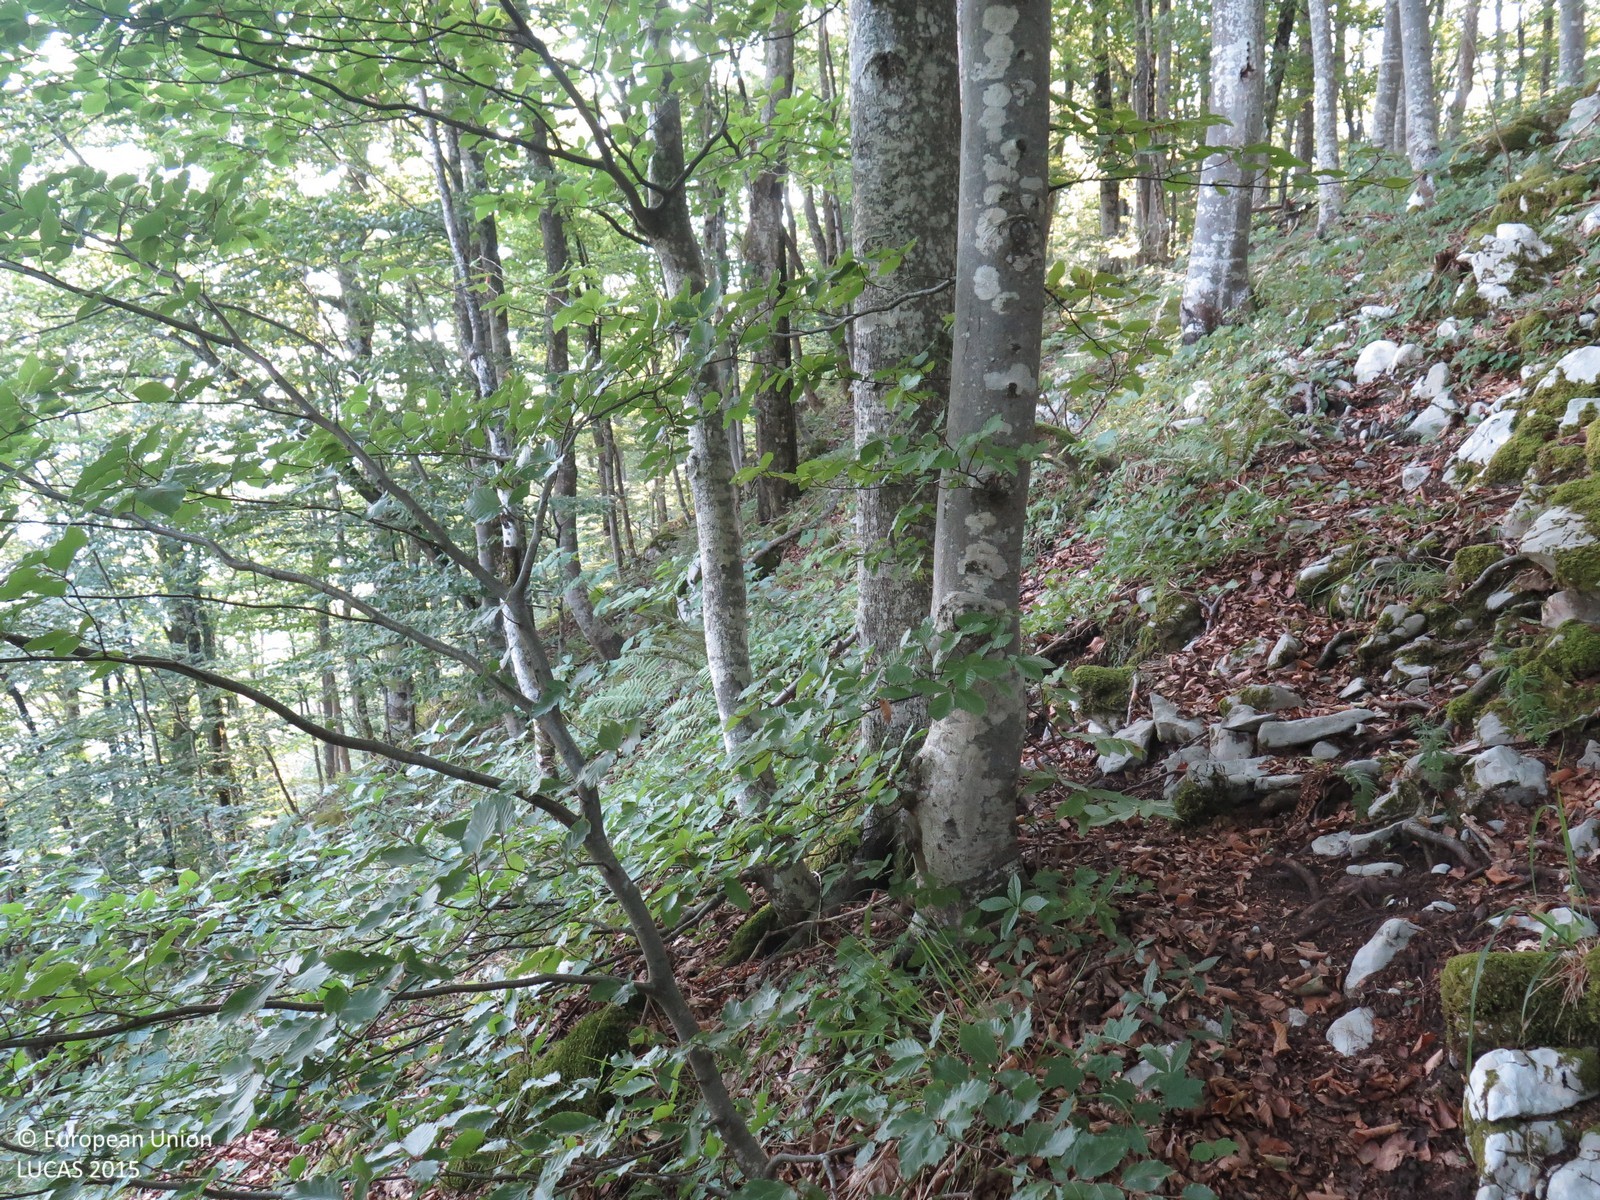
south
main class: Woodland
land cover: Broadleaved woodland
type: mountainous beech forest
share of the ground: > 75 %
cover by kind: broadleaved forest trees 90 %, herbaceous plants 5 %, unconsolidated bare surface 5 %
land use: Forestry
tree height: > 5 m
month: August
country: HR
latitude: 45.4943
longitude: 14.9990
